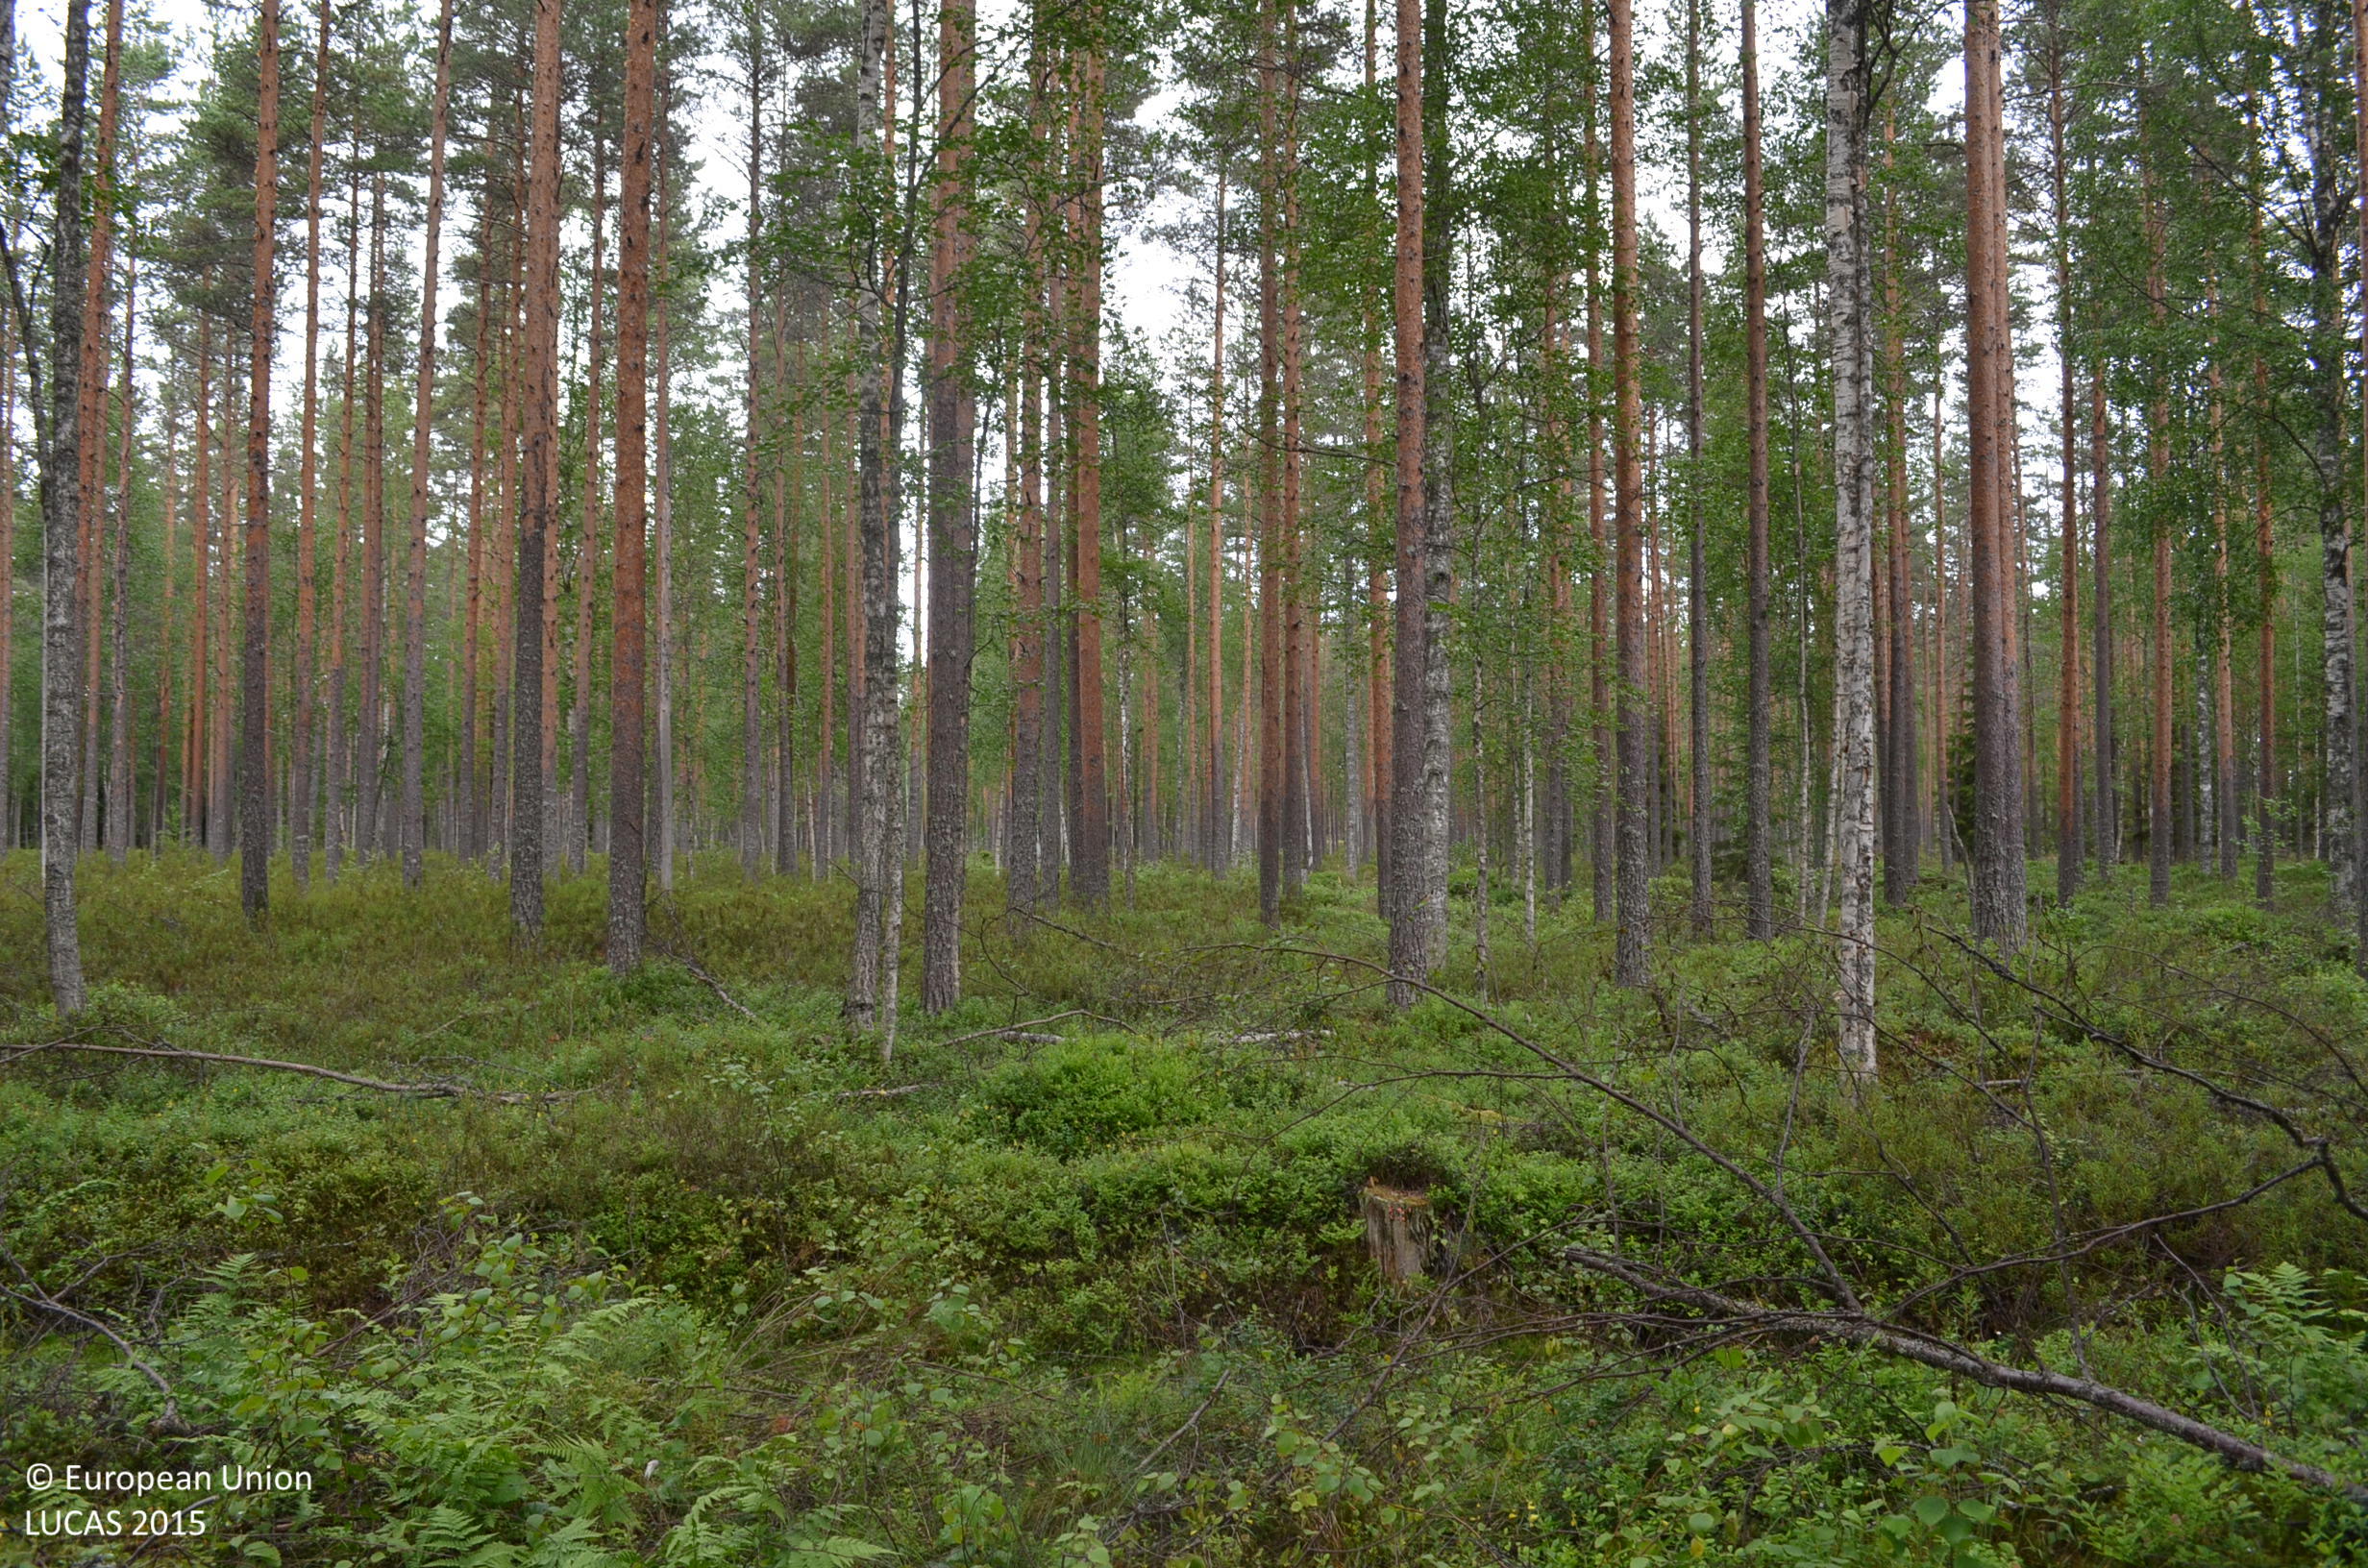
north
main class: Woodland
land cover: Pine dominated mixed woodland
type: boreal forest
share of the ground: > 75 %
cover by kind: coniferous forest trees 55 %, shrubs 25 %, broadleaved forest trees 20 %
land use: Forestry
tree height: > 5 m
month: July
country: FI
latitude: 62.2511
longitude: 23.5704
